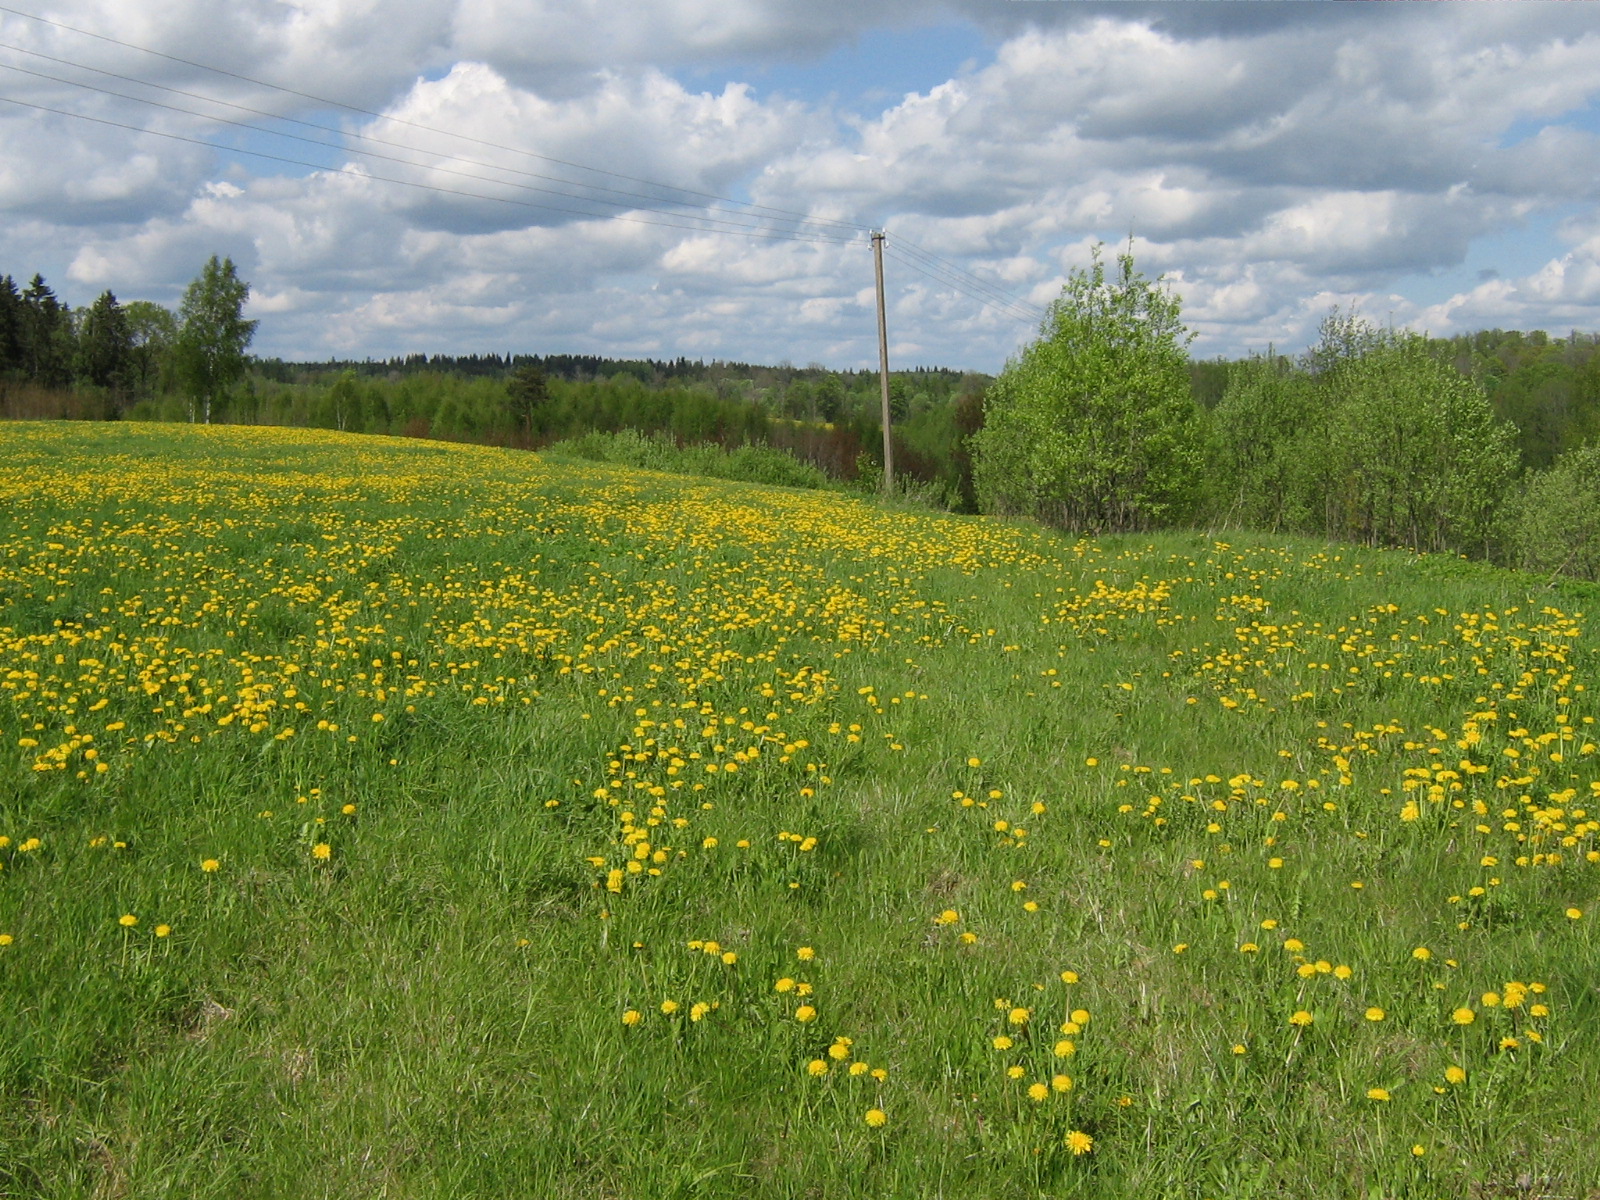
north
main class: Grassland
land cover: Grassland without tree/shrub cover
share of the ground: > 75 %
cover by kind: herbaceous plants 100 %
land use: Agriculture (excluding fallow land and kitchen gardens)
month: May
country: LV
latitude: 57.2237
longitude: 25.7751
